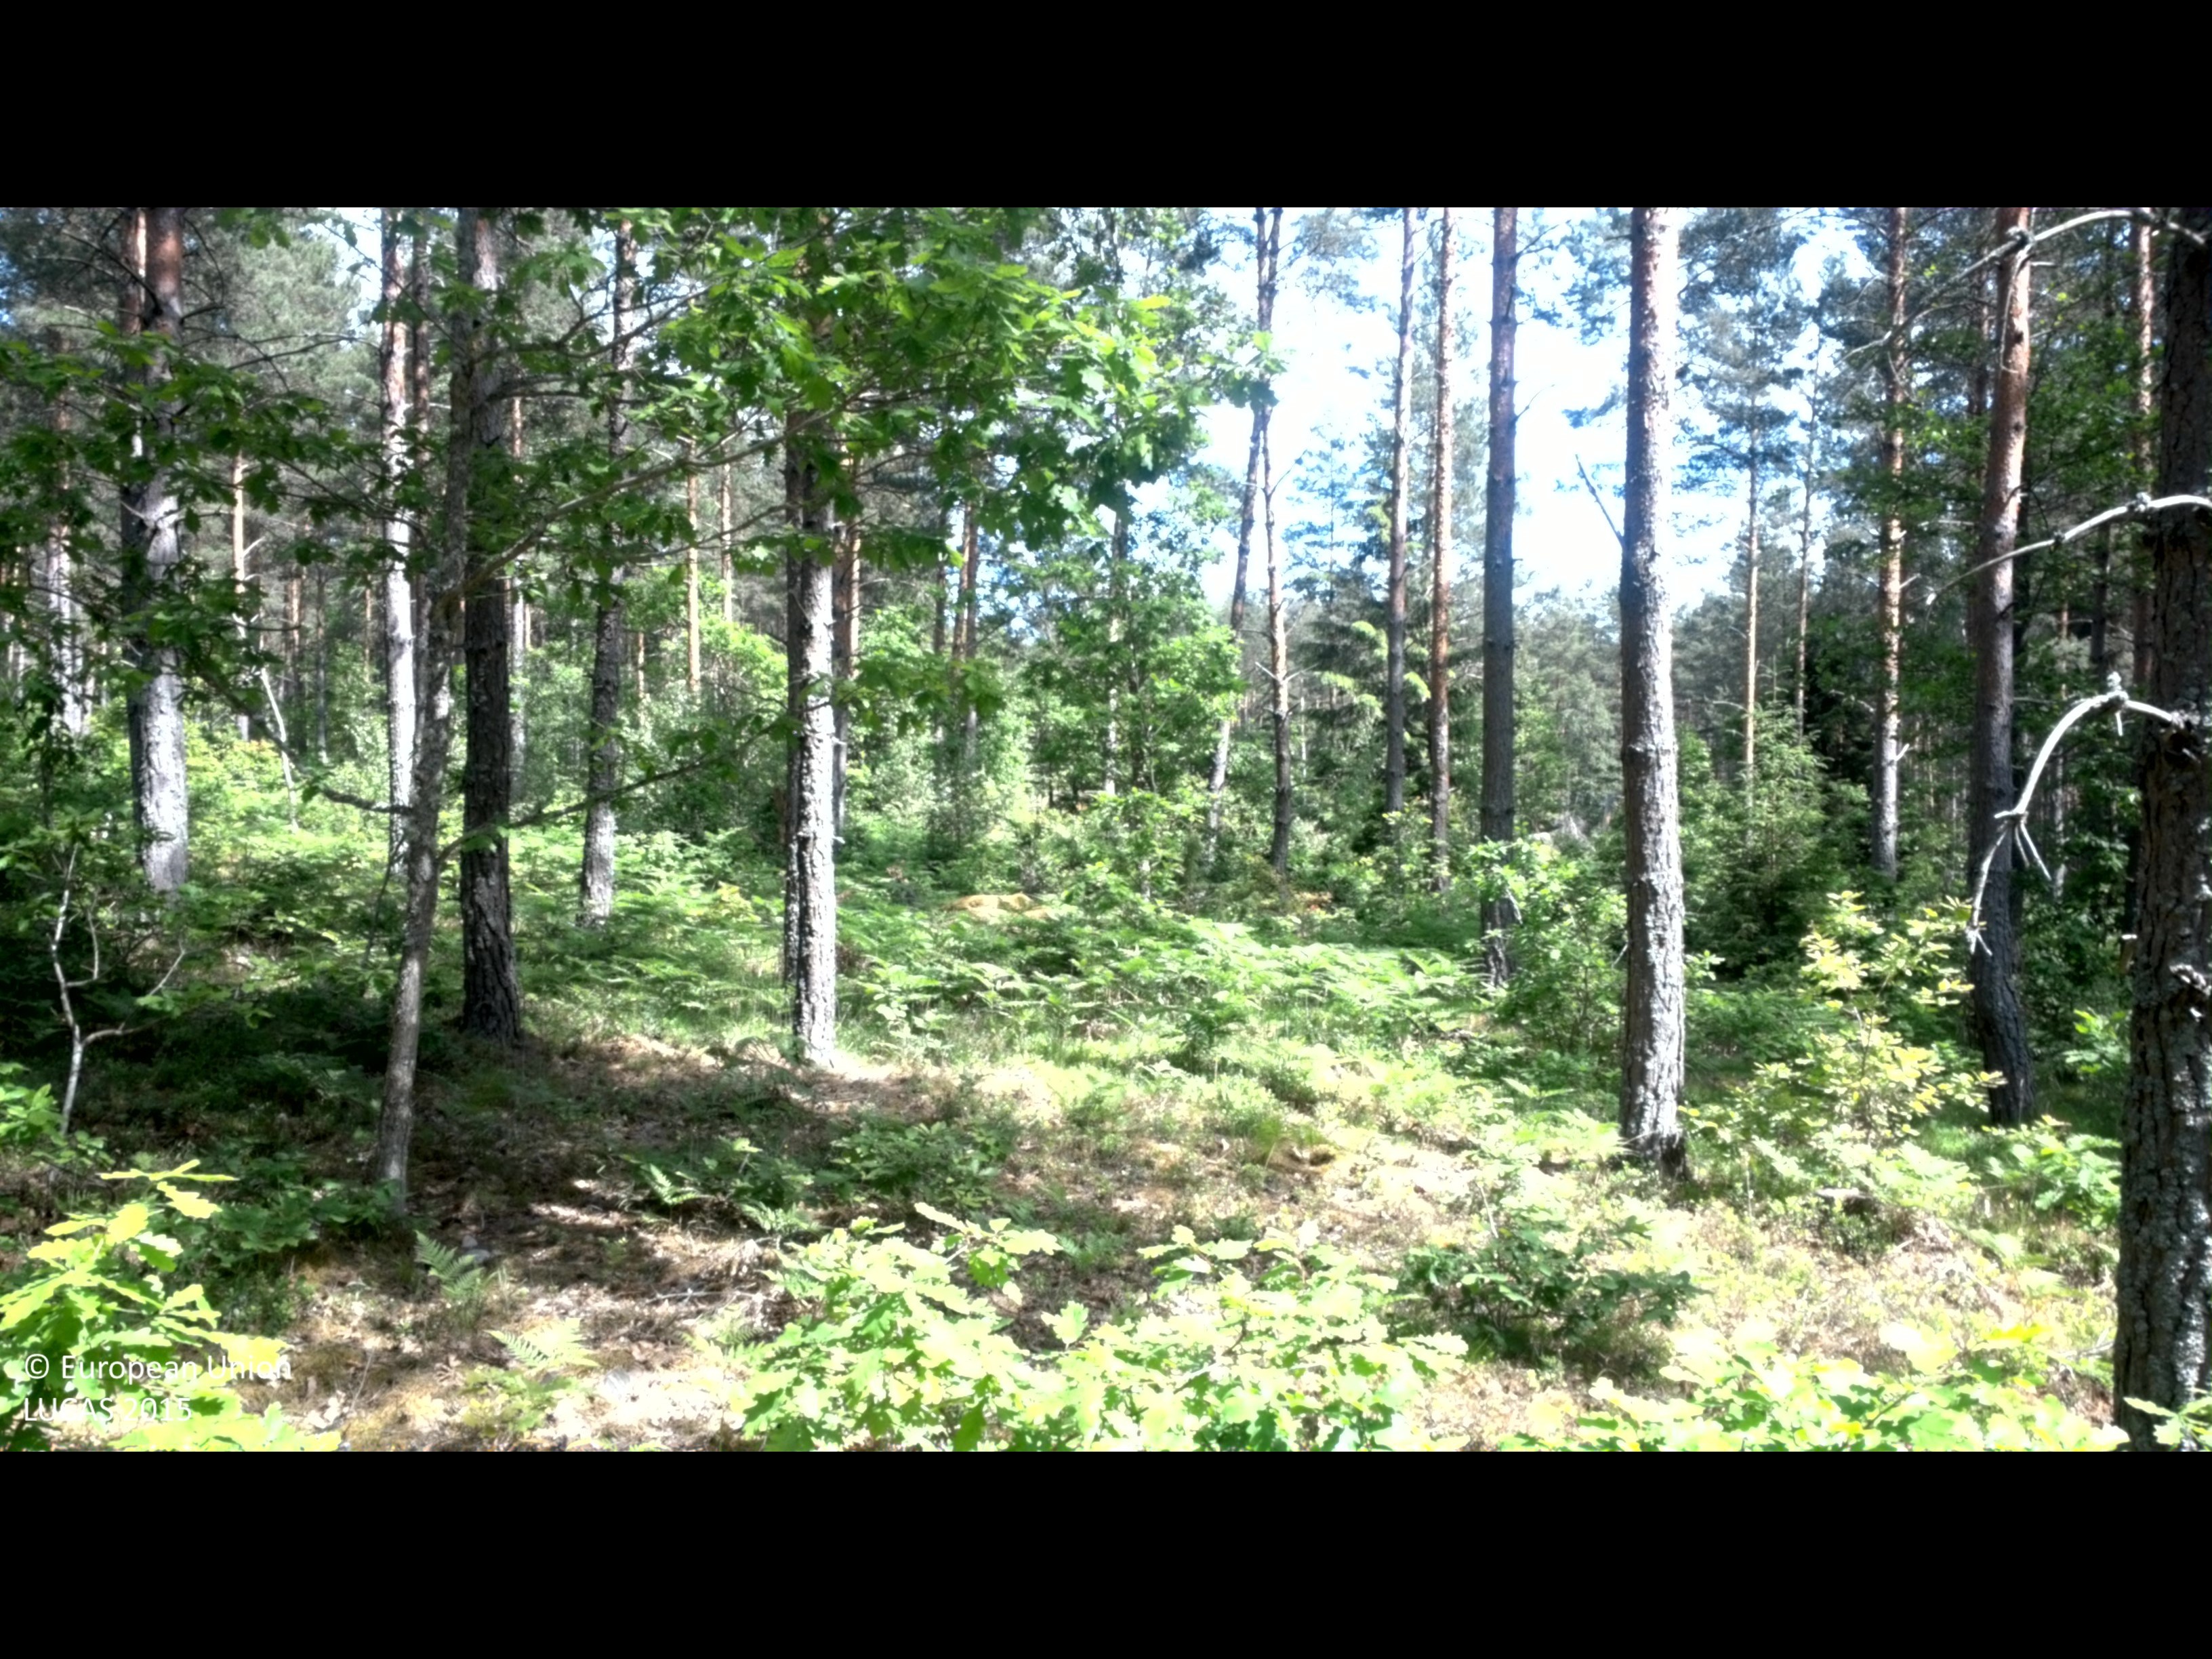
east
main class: Woodland
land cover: Pine dominated mixed woodland
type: boreal forest
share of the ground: 50 - 75 %
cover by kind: coniferous forest trees 45 %, broadleaved forest trees 20 %, herbaceous plants 15 %, shrubs 10 %, lichens and mosses 10 %
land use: Forestry
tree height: > 5 m
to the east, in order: Pine dominated mixed woodland; Pine dominated coniferous woodland; Shrubland with sparse tree cover; Pine dominated coniferous woodland
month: June
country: SE
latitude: 57.6072
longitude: 16.5765
